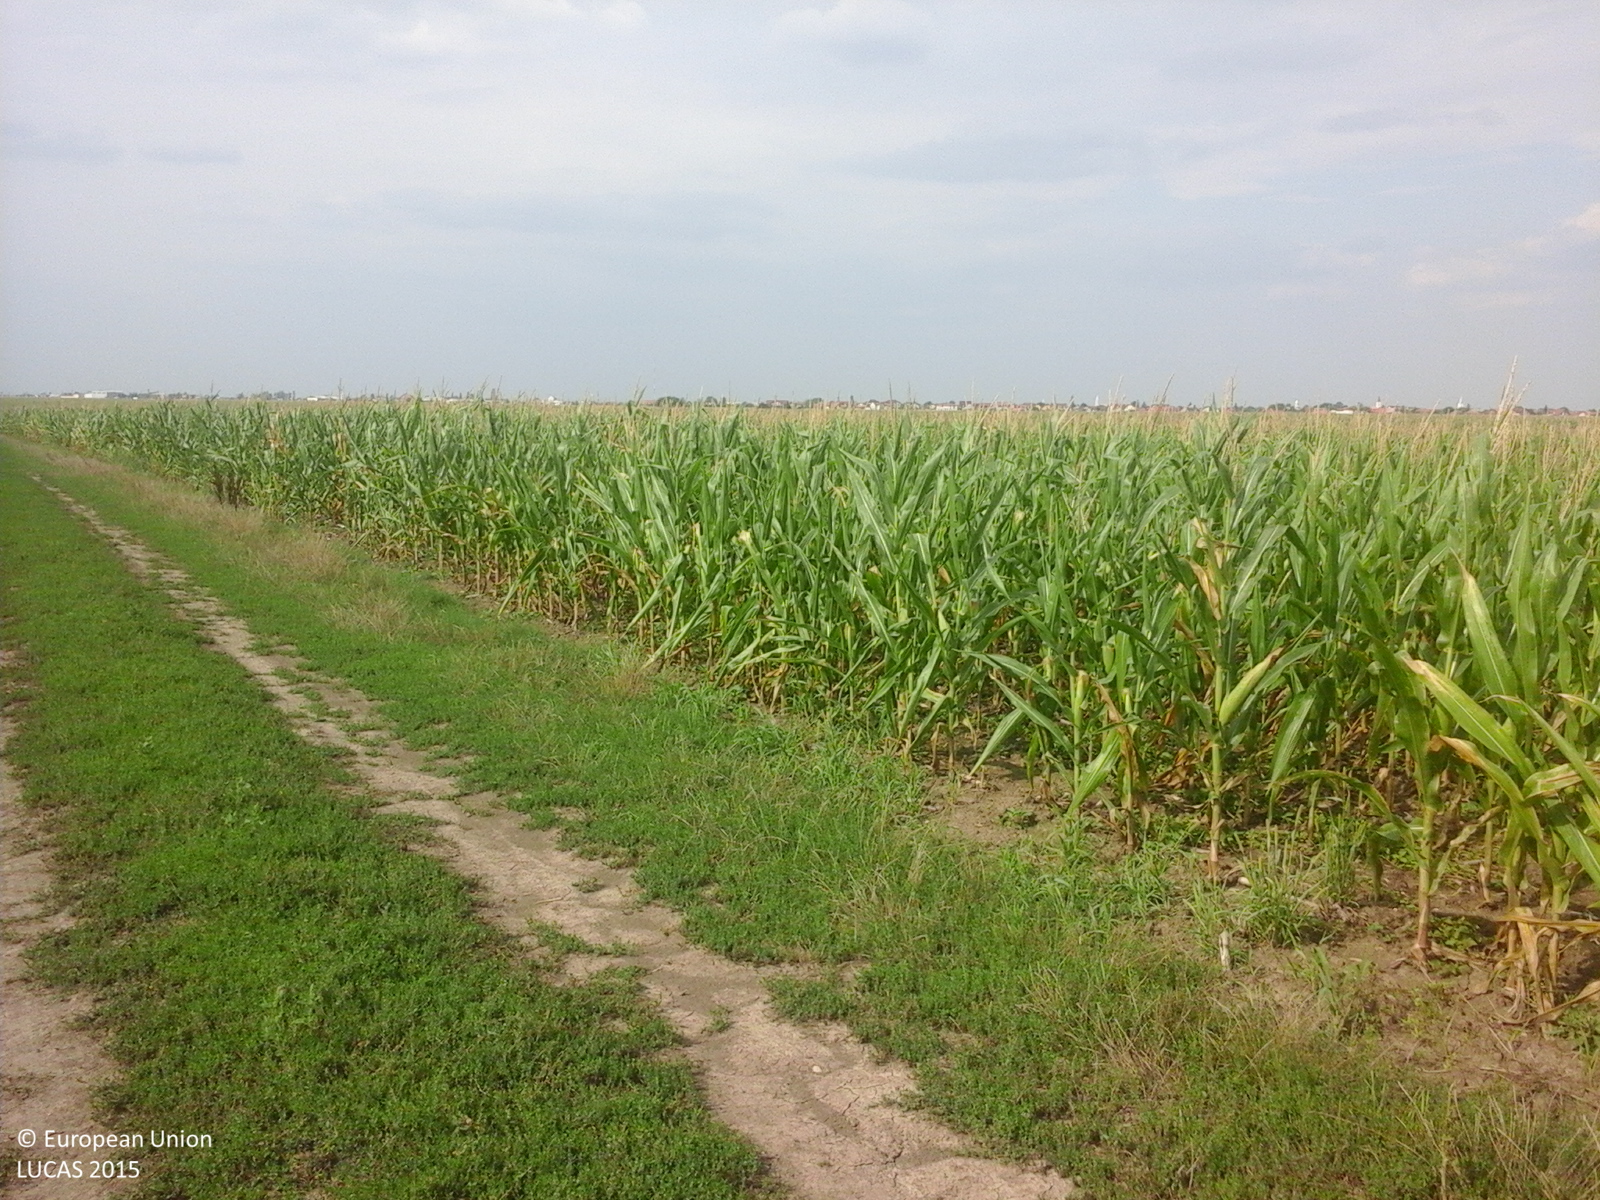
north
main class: Cropland
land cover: Maize
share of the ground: > 75 %
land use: Agriculture (excluding fallow land and kitchen gardens)
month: August
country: RO
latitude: 46.1970
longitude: 21.3733
